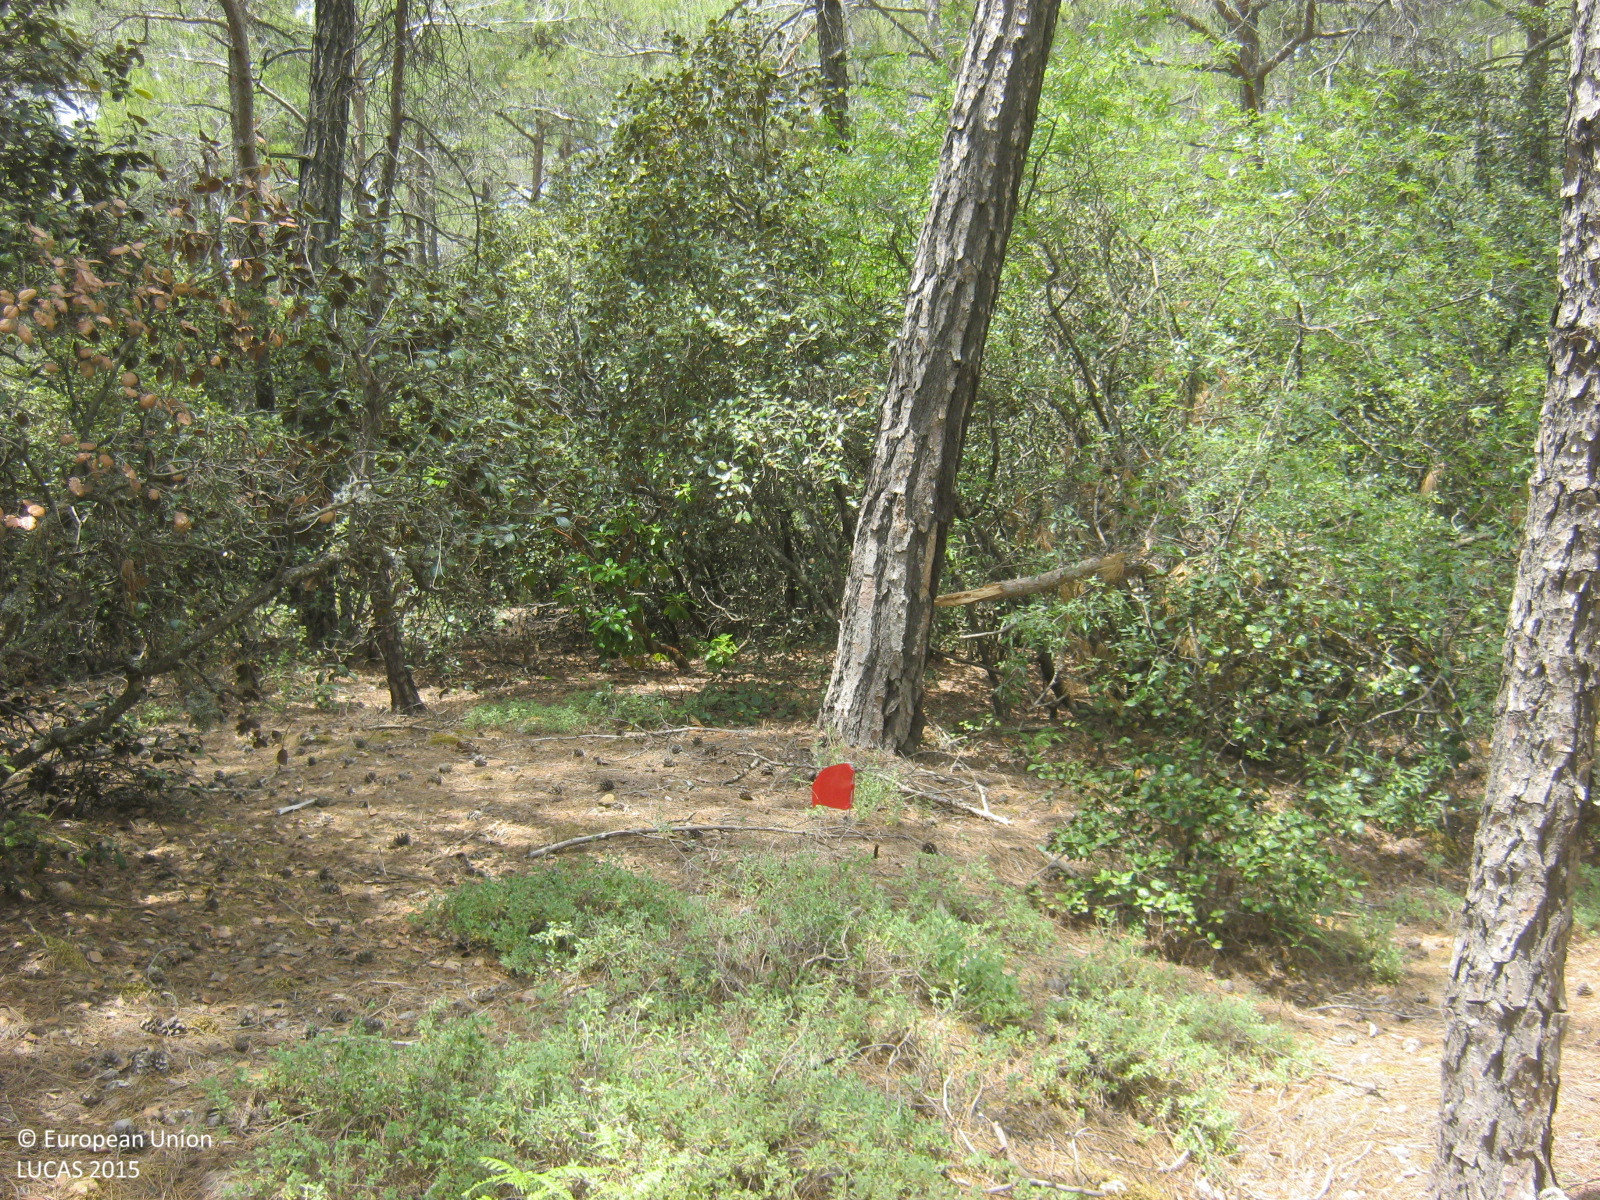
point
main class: Woodland
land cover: Pine dominated mixed woodland
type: coniferous forest of the mediterranean region
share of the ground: > 75 %
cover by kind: coniferous forest trees 60 %, broadleaved forest trees 30 %, shrubs 10 %
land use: Forestry
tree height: > 5 m
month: June
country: CY
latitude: 34.9639
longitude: 32.8483
